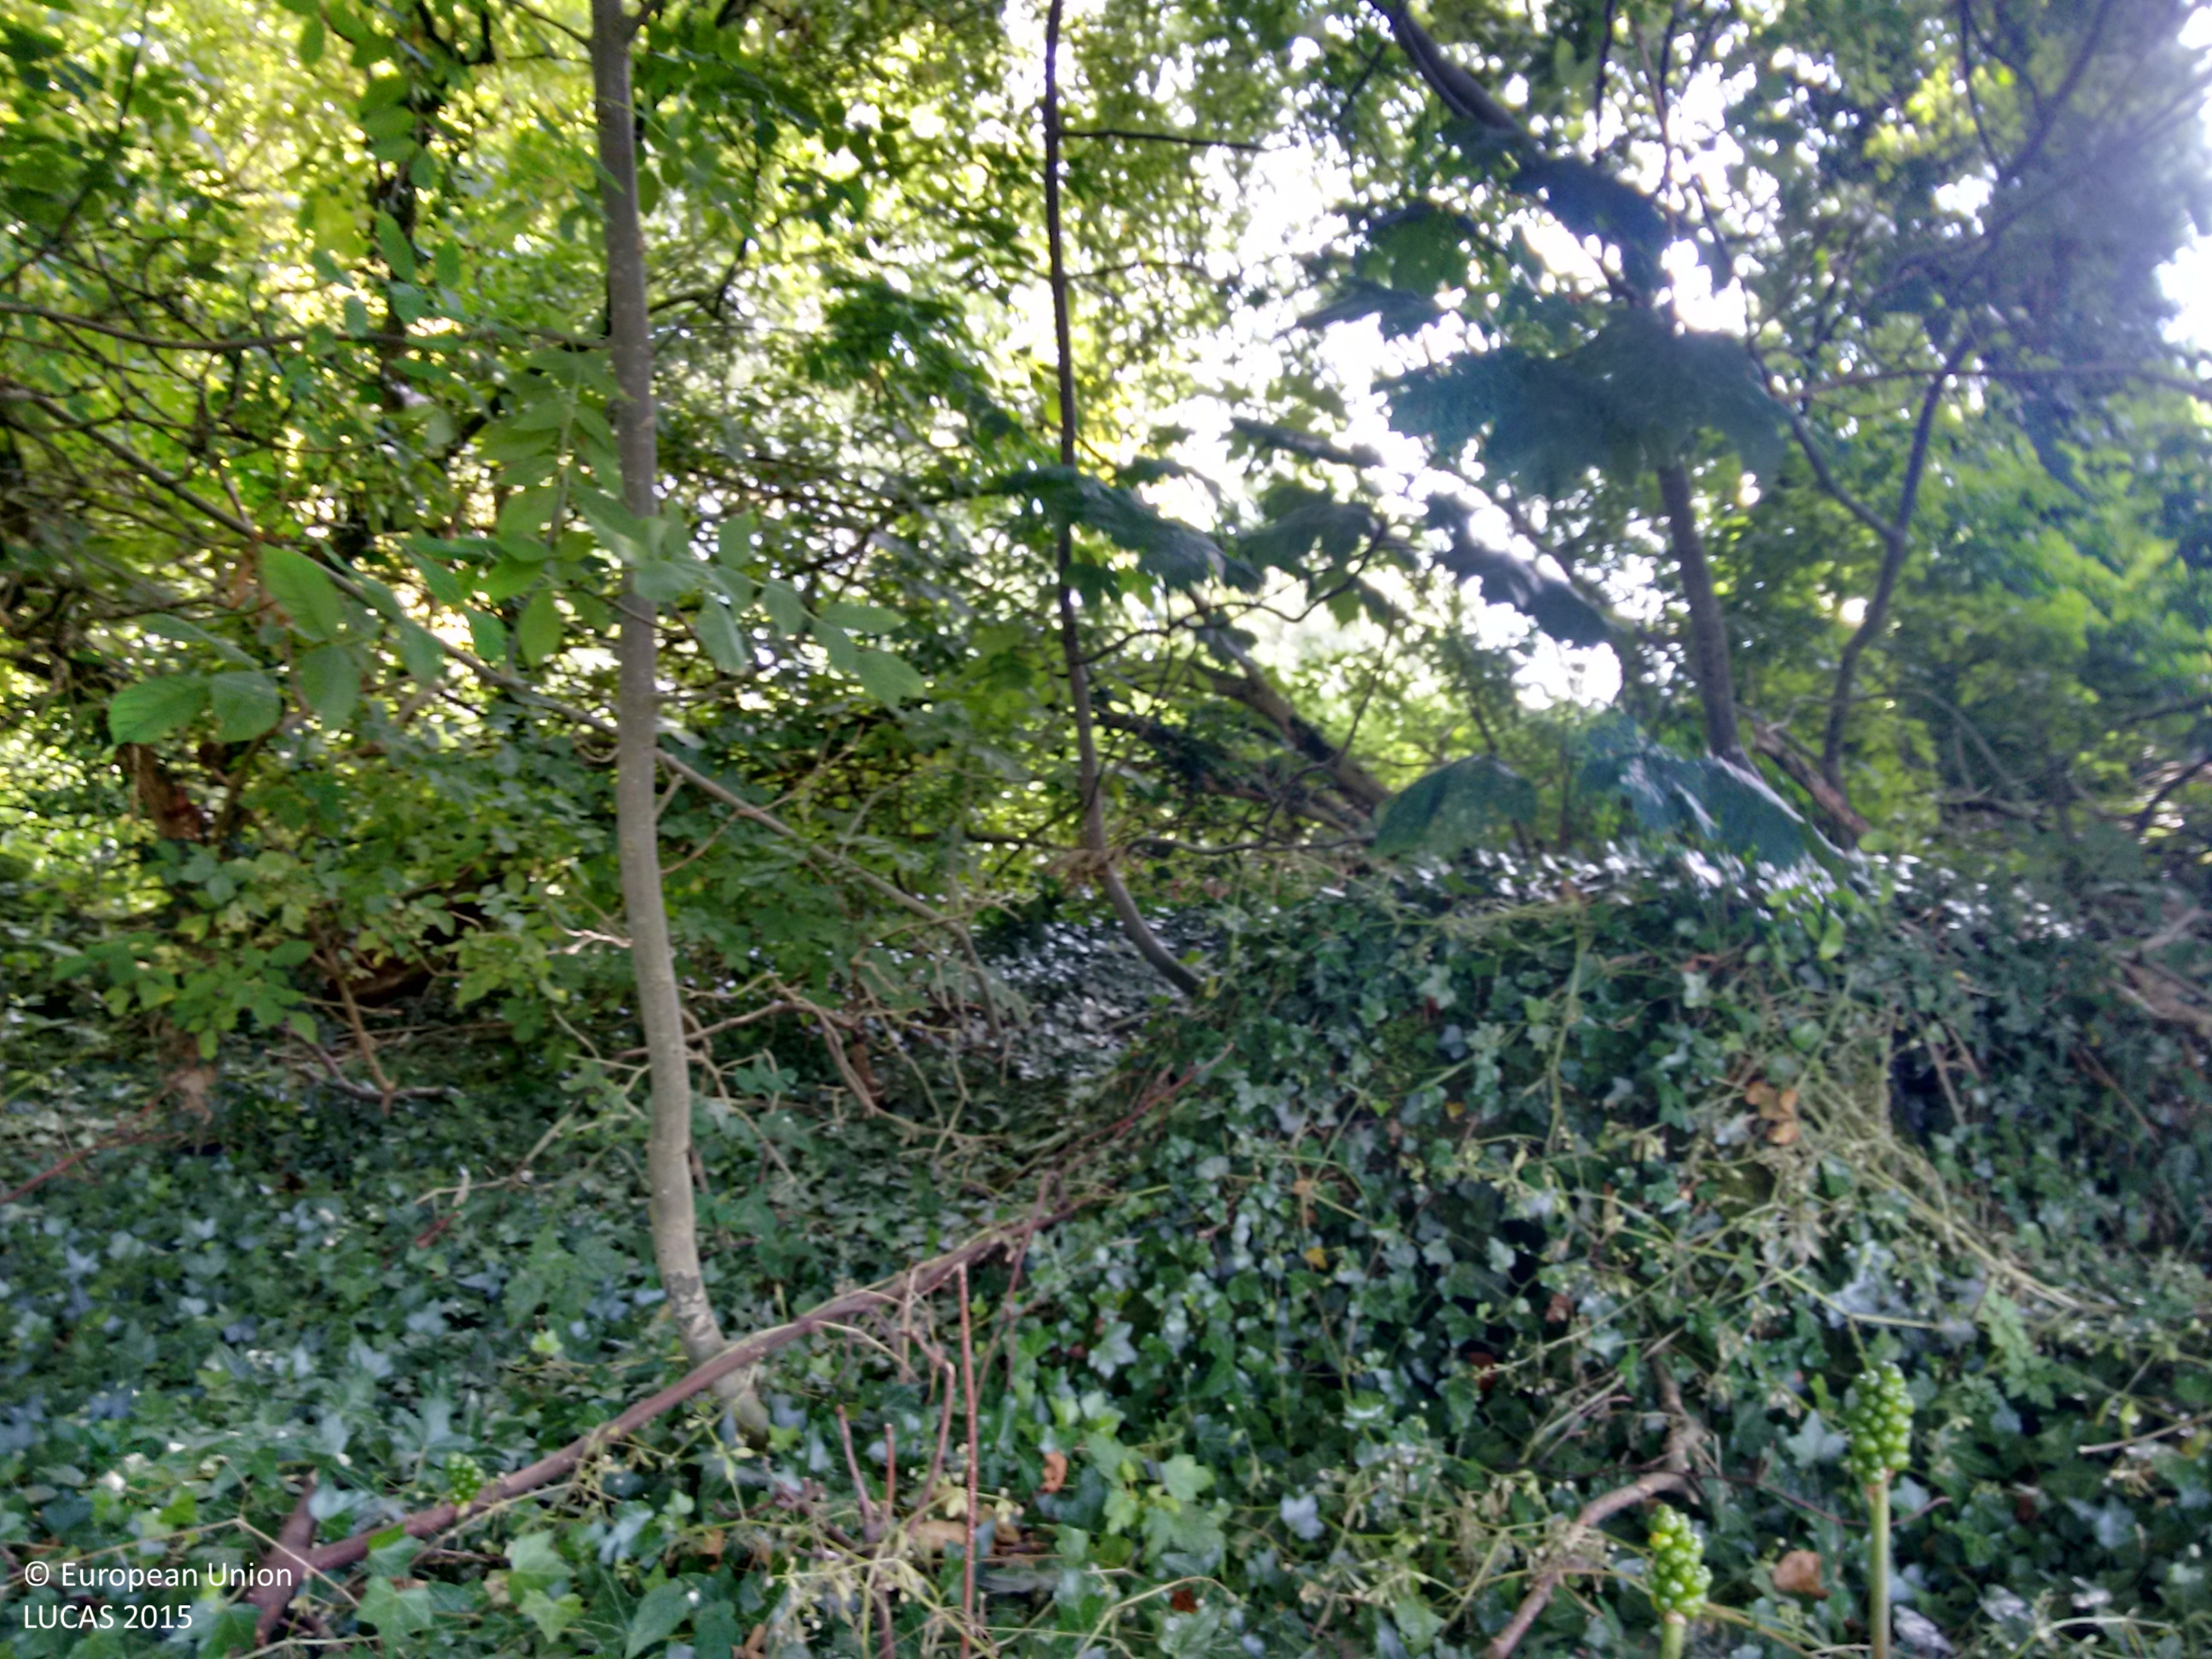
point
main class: Woodland
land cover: Broadleaved woodland
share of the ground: > 75 %
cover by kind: broadleaved forest trees 70 %, herbaceous plants 30 %
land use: Agriculture (excluding fallow land and kitchen gardens)
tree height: > 5 m
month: August
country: GB
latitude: 54.7468
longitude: -3.2662
